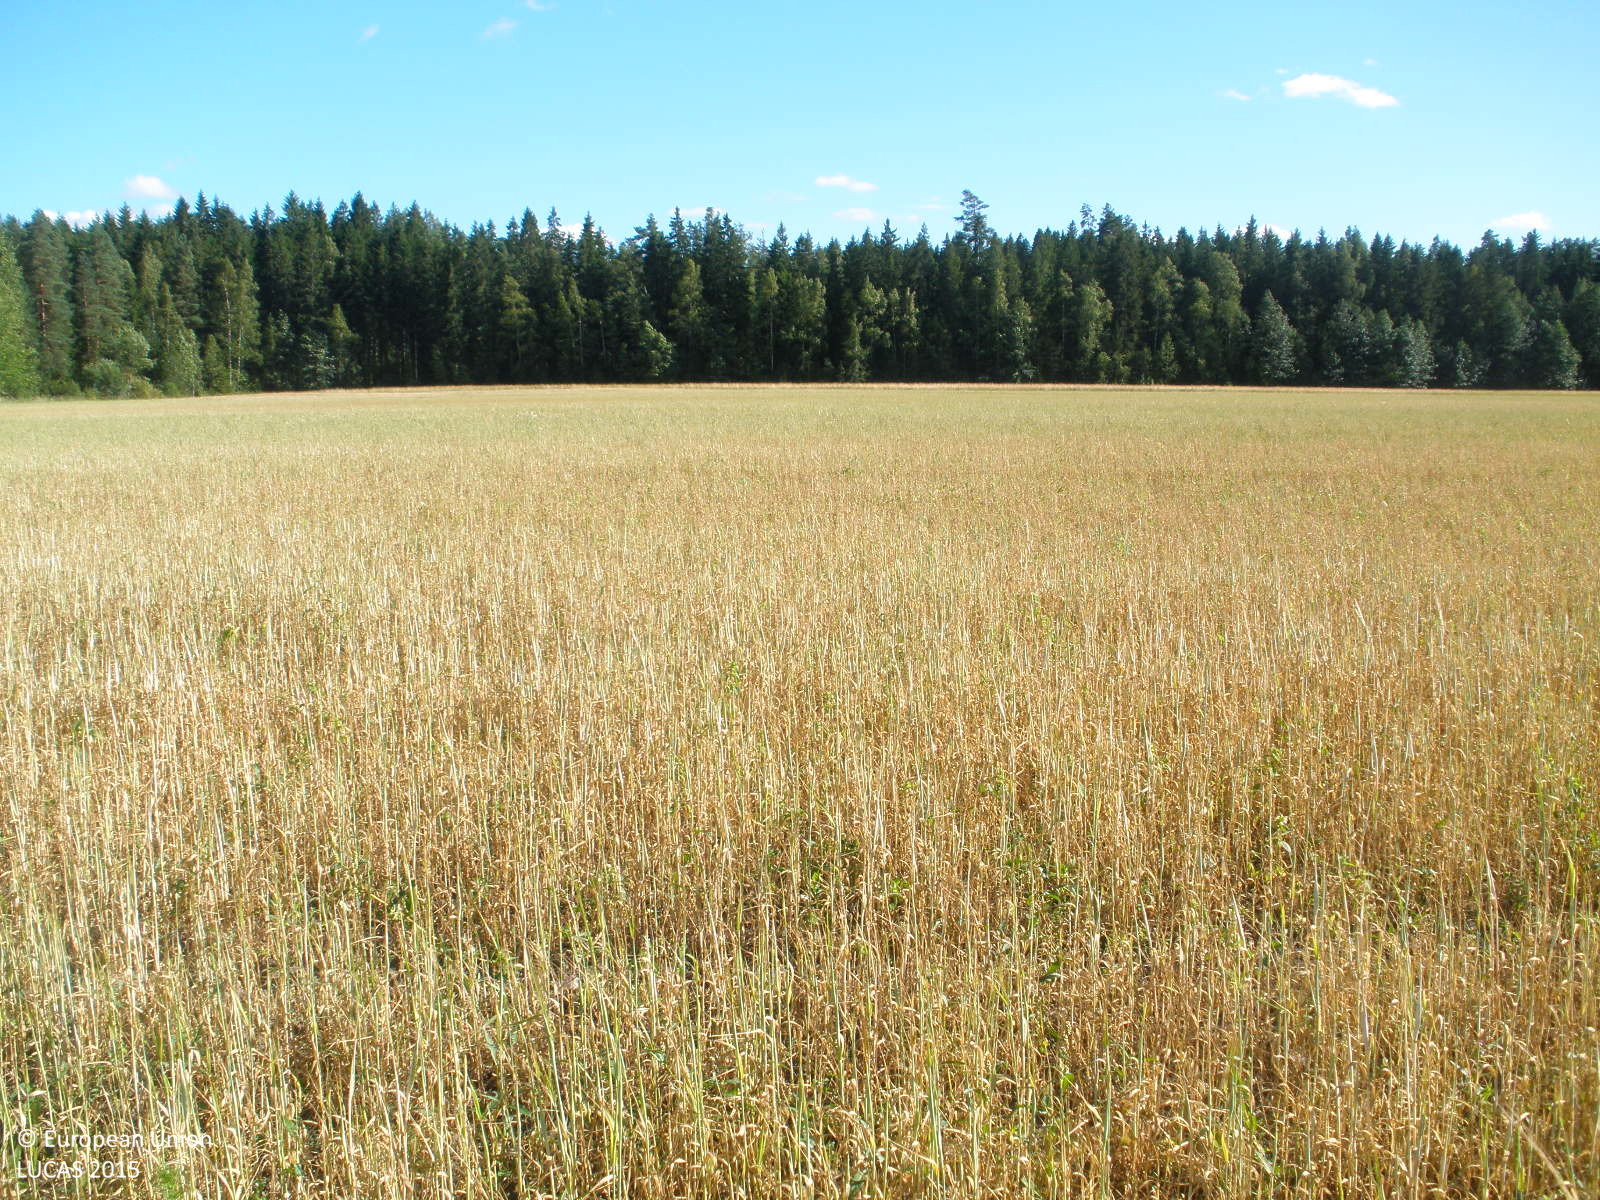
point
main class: Cropland
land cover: Barley
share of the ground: 50 - 75 %
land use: Agriculture (excluding fallow land and kitchen gardens)
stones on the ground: < 10 %
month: August
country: FI
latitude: 60.5498
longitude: 23.3392
